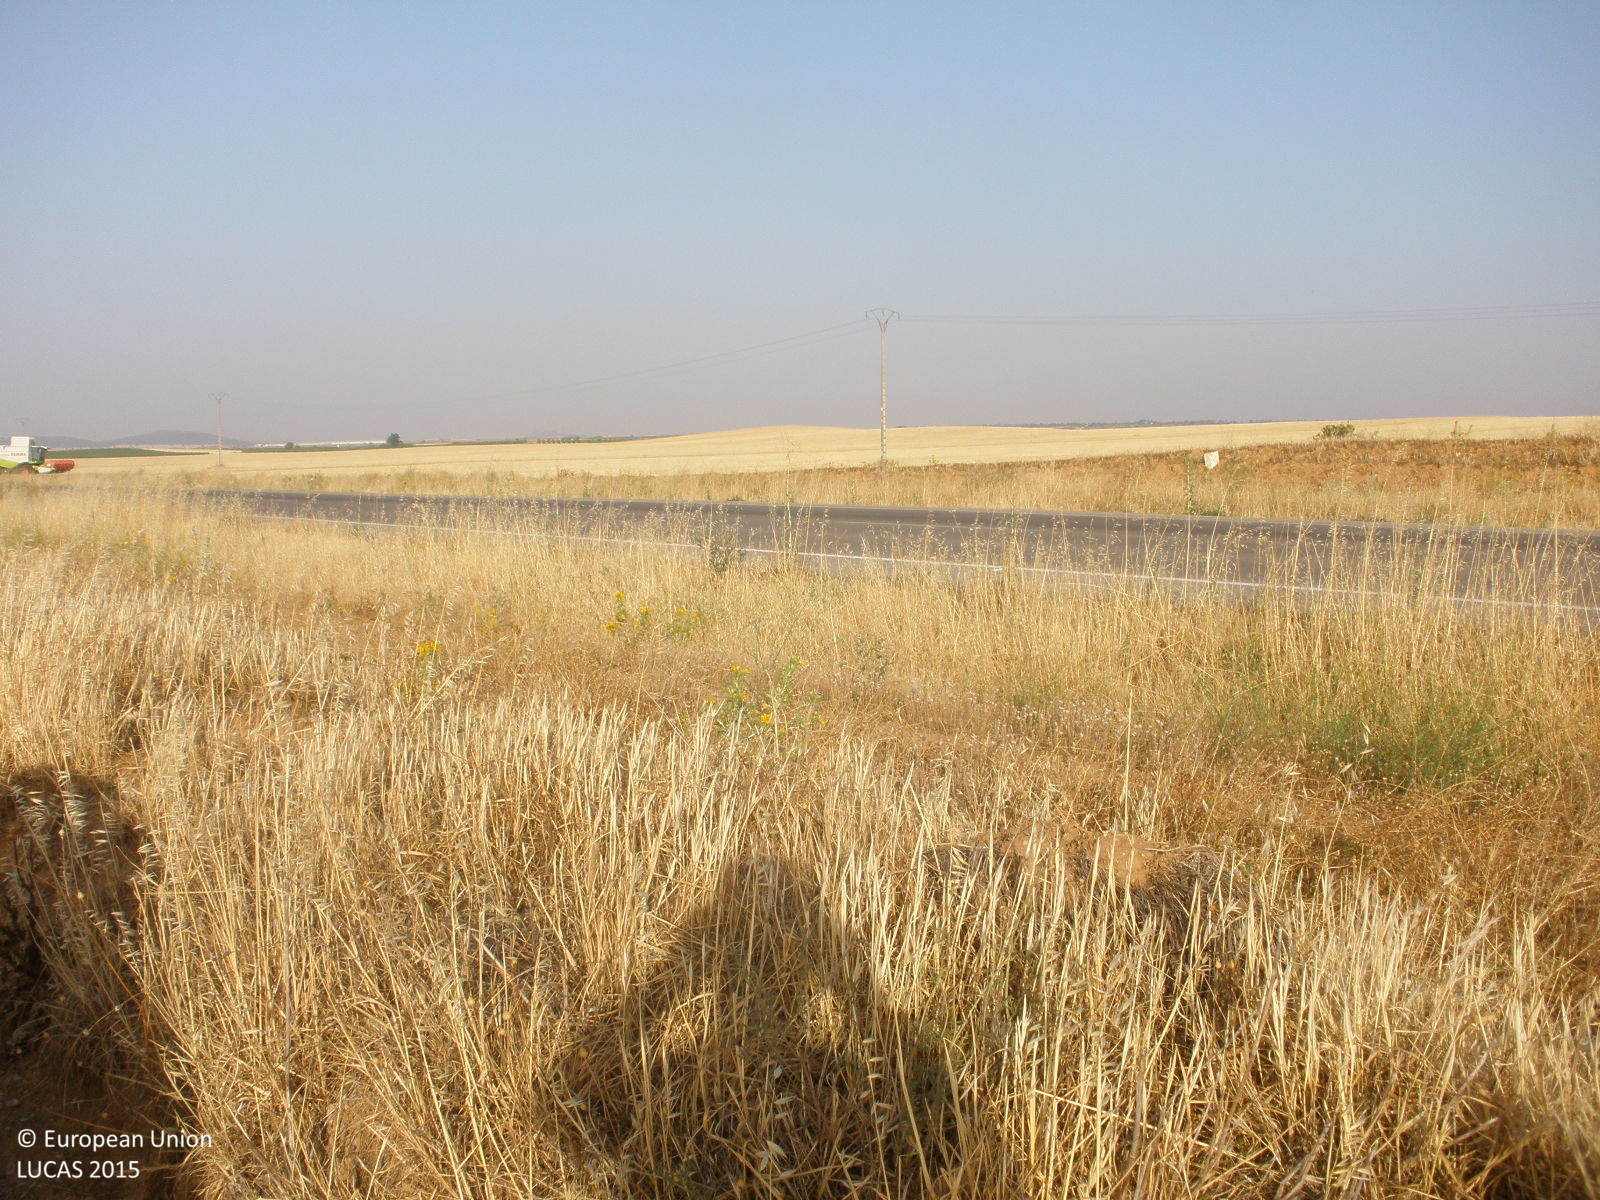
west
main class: Cropland
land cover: Oats
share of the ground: < 10 %
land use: Agriculture (excluding fallow land and kitchen gardens)
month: July
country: ES
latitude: 39.8037
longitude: -3.1155
